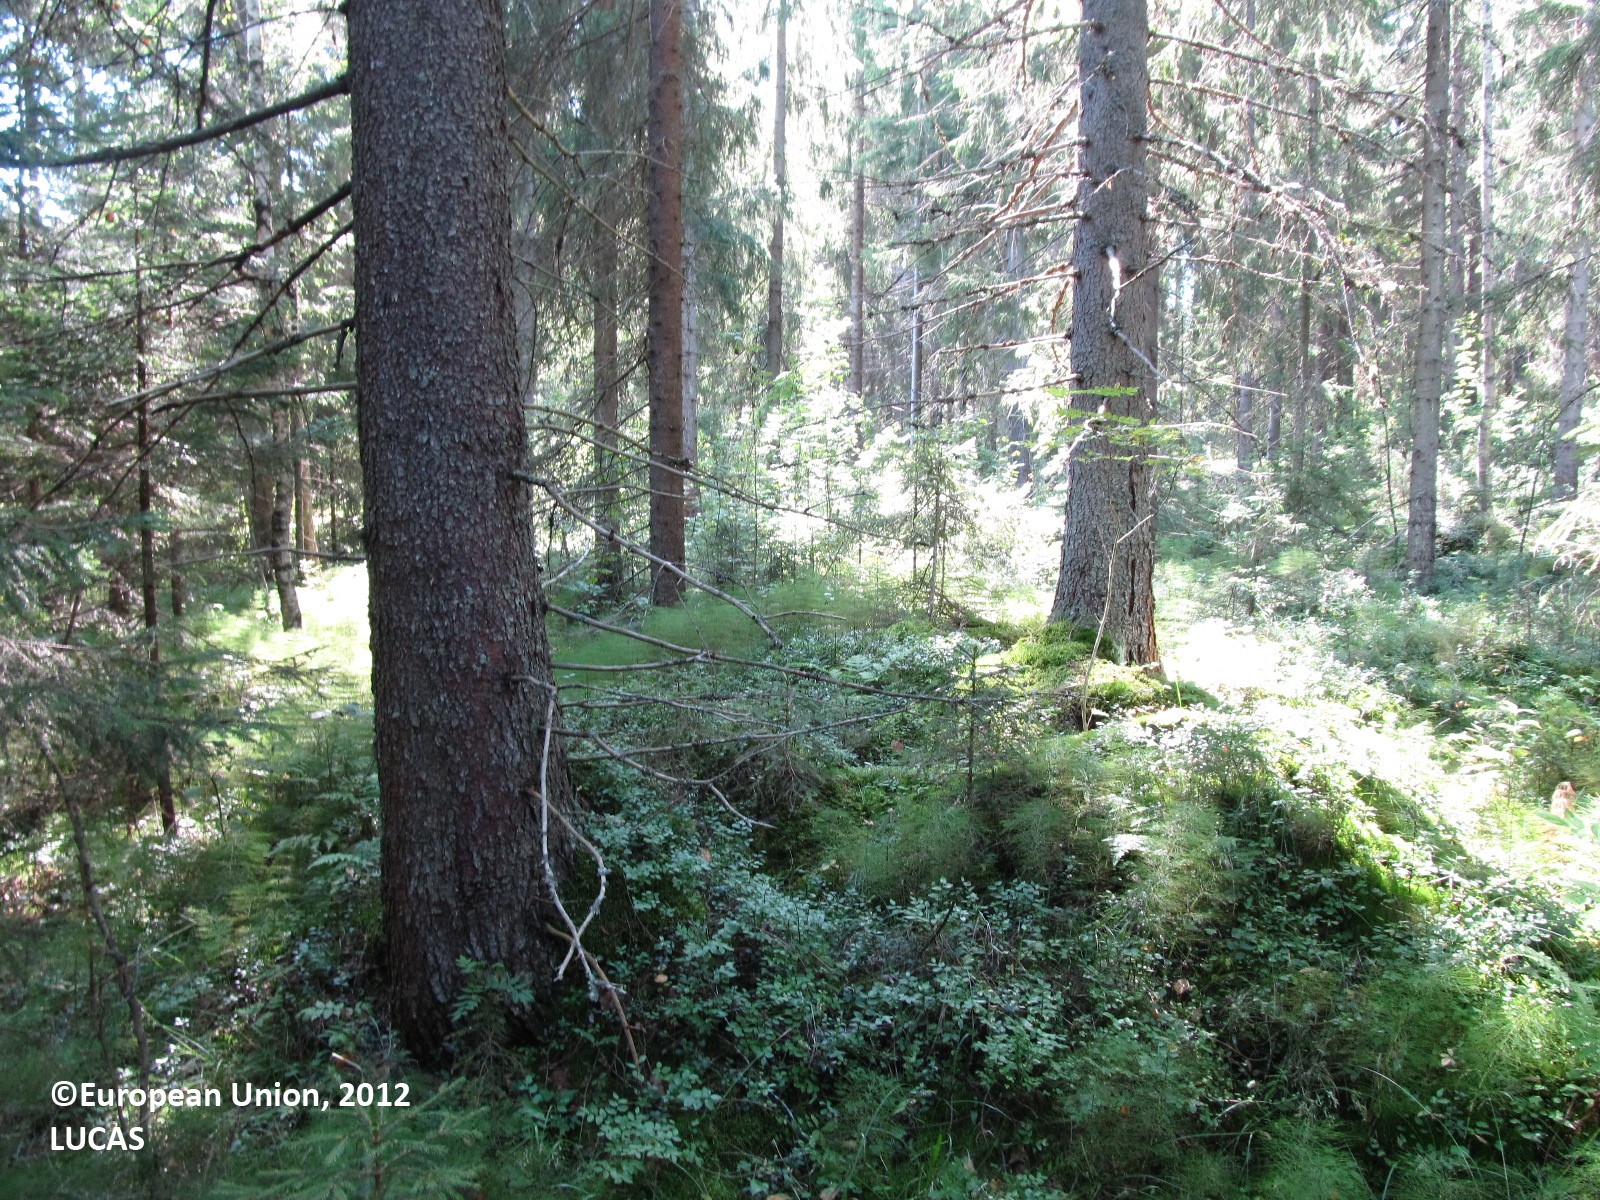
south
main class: Woodland
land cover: Spruce dominated coniferous woodland
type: boreal forest
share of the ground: 50 - 75 %
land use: Forestry
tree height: > 5 m
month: August
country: FI
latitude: 62.3010
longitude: 27.7852
